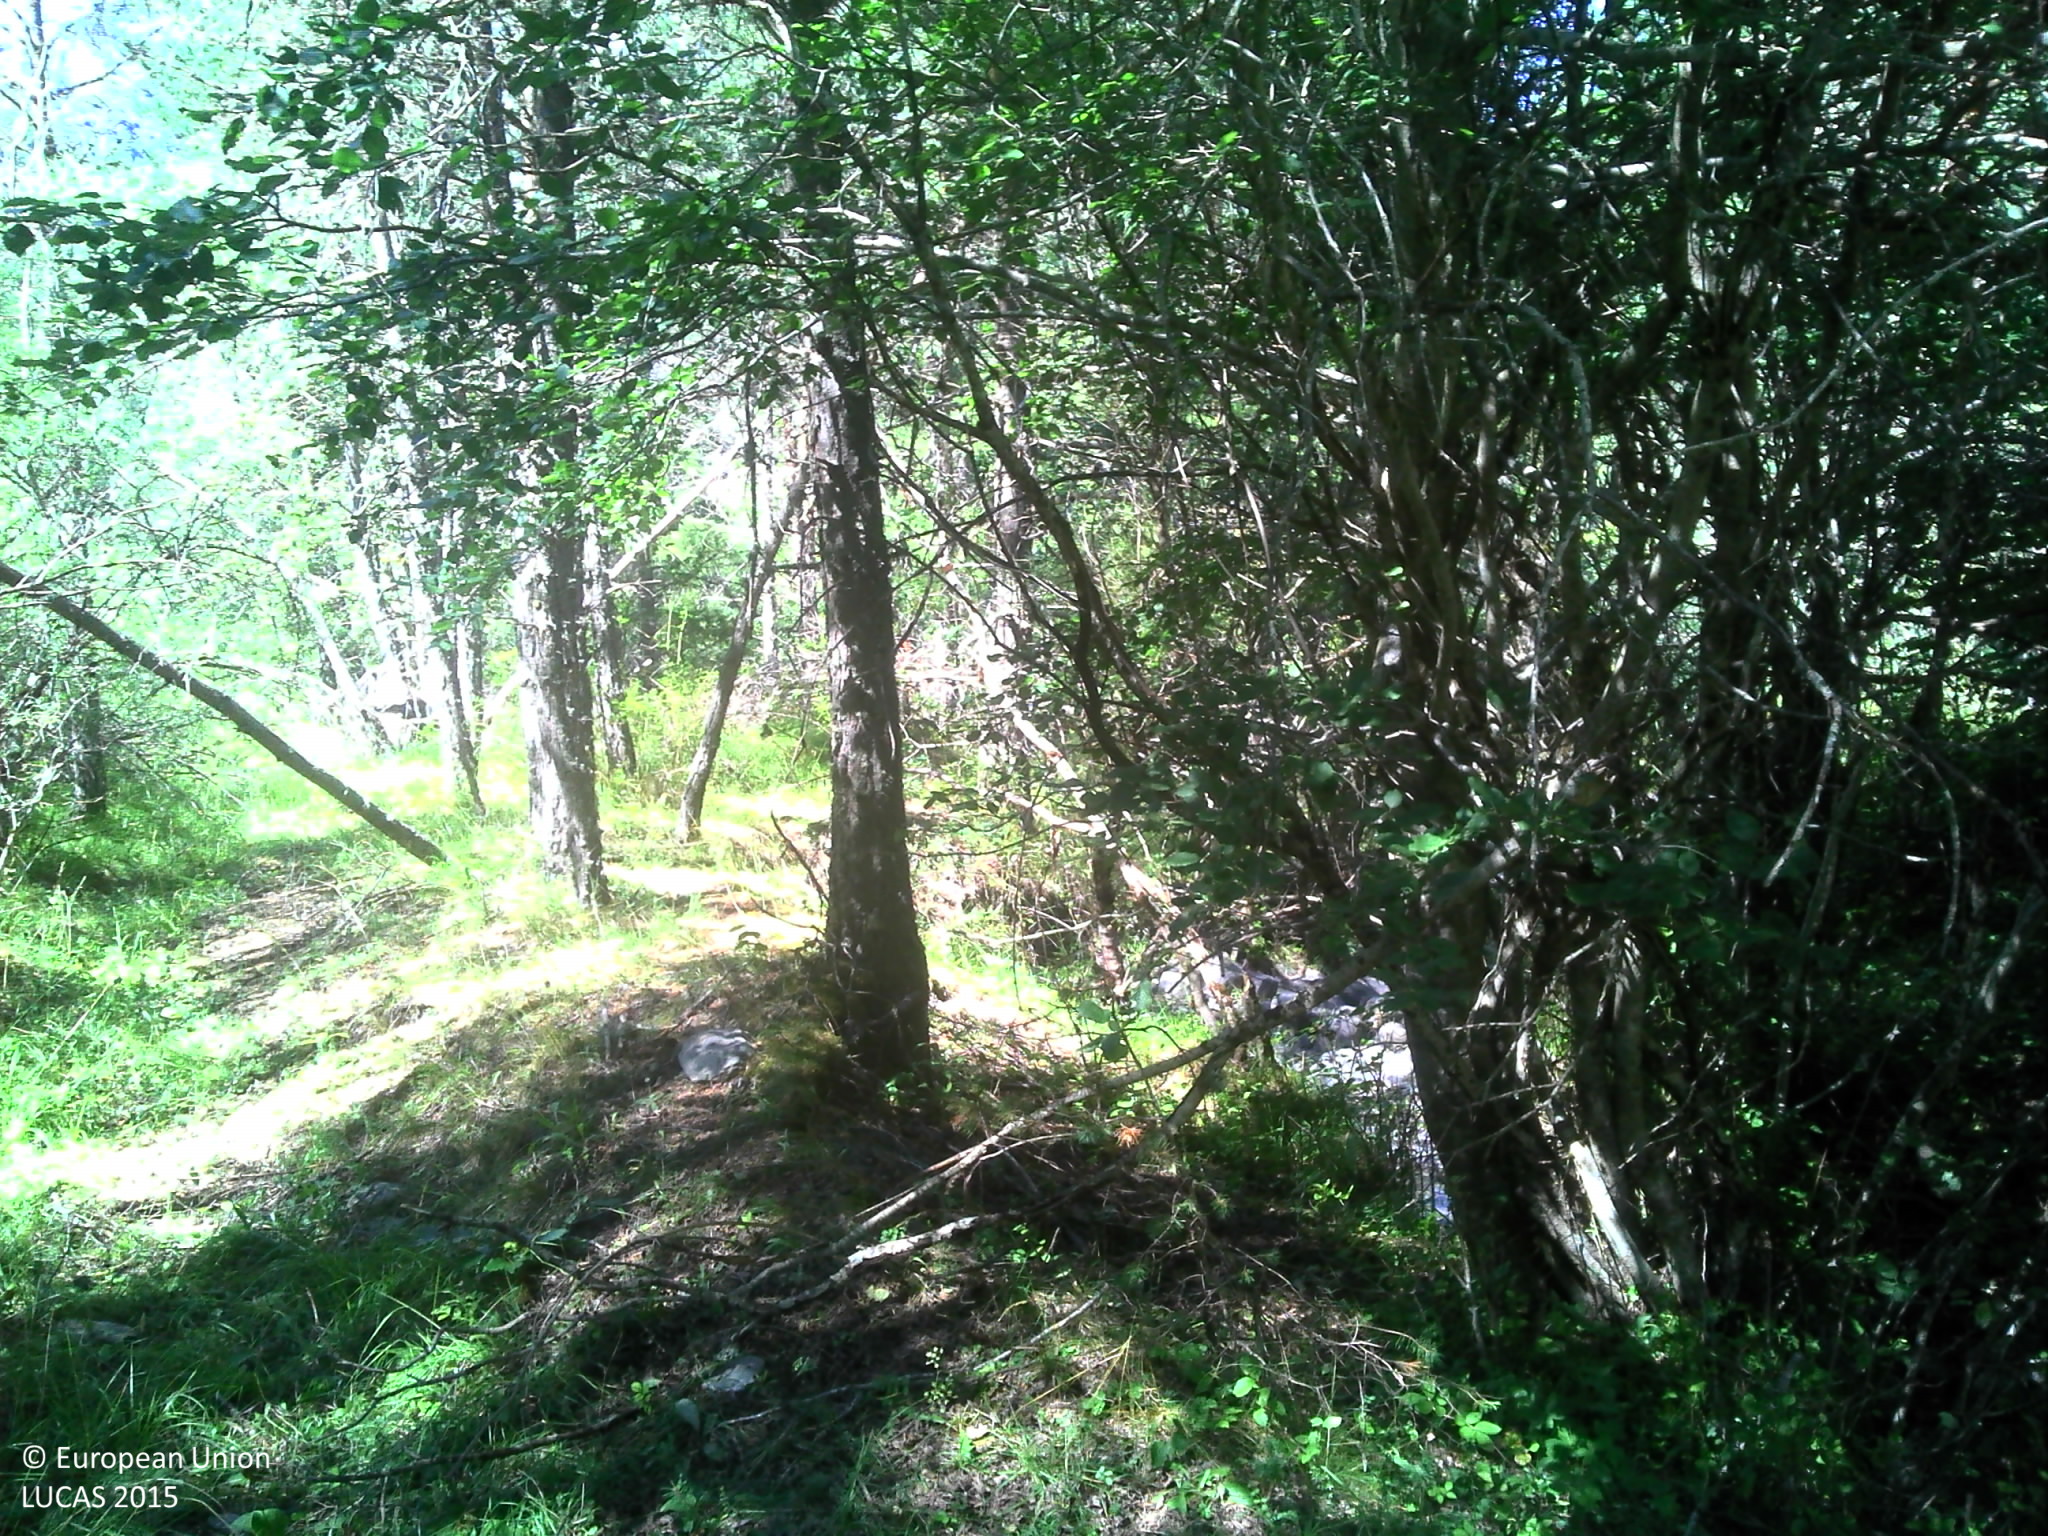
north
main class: Woodland
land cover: Pine dominated mixed woodland
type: alpine coniferous forest
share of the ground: 50 - 75 %
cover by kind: coniferous forest trees 30 %, broadleaved forest trees 20 %, shrubs 20 %, herbaceous plants 20 %, consolidated bare surface 10 %
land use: Forestry
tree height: > 5 m
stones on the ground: 10 - 25 %
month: August
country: FR
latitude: 44.3363
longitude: 6.2319
